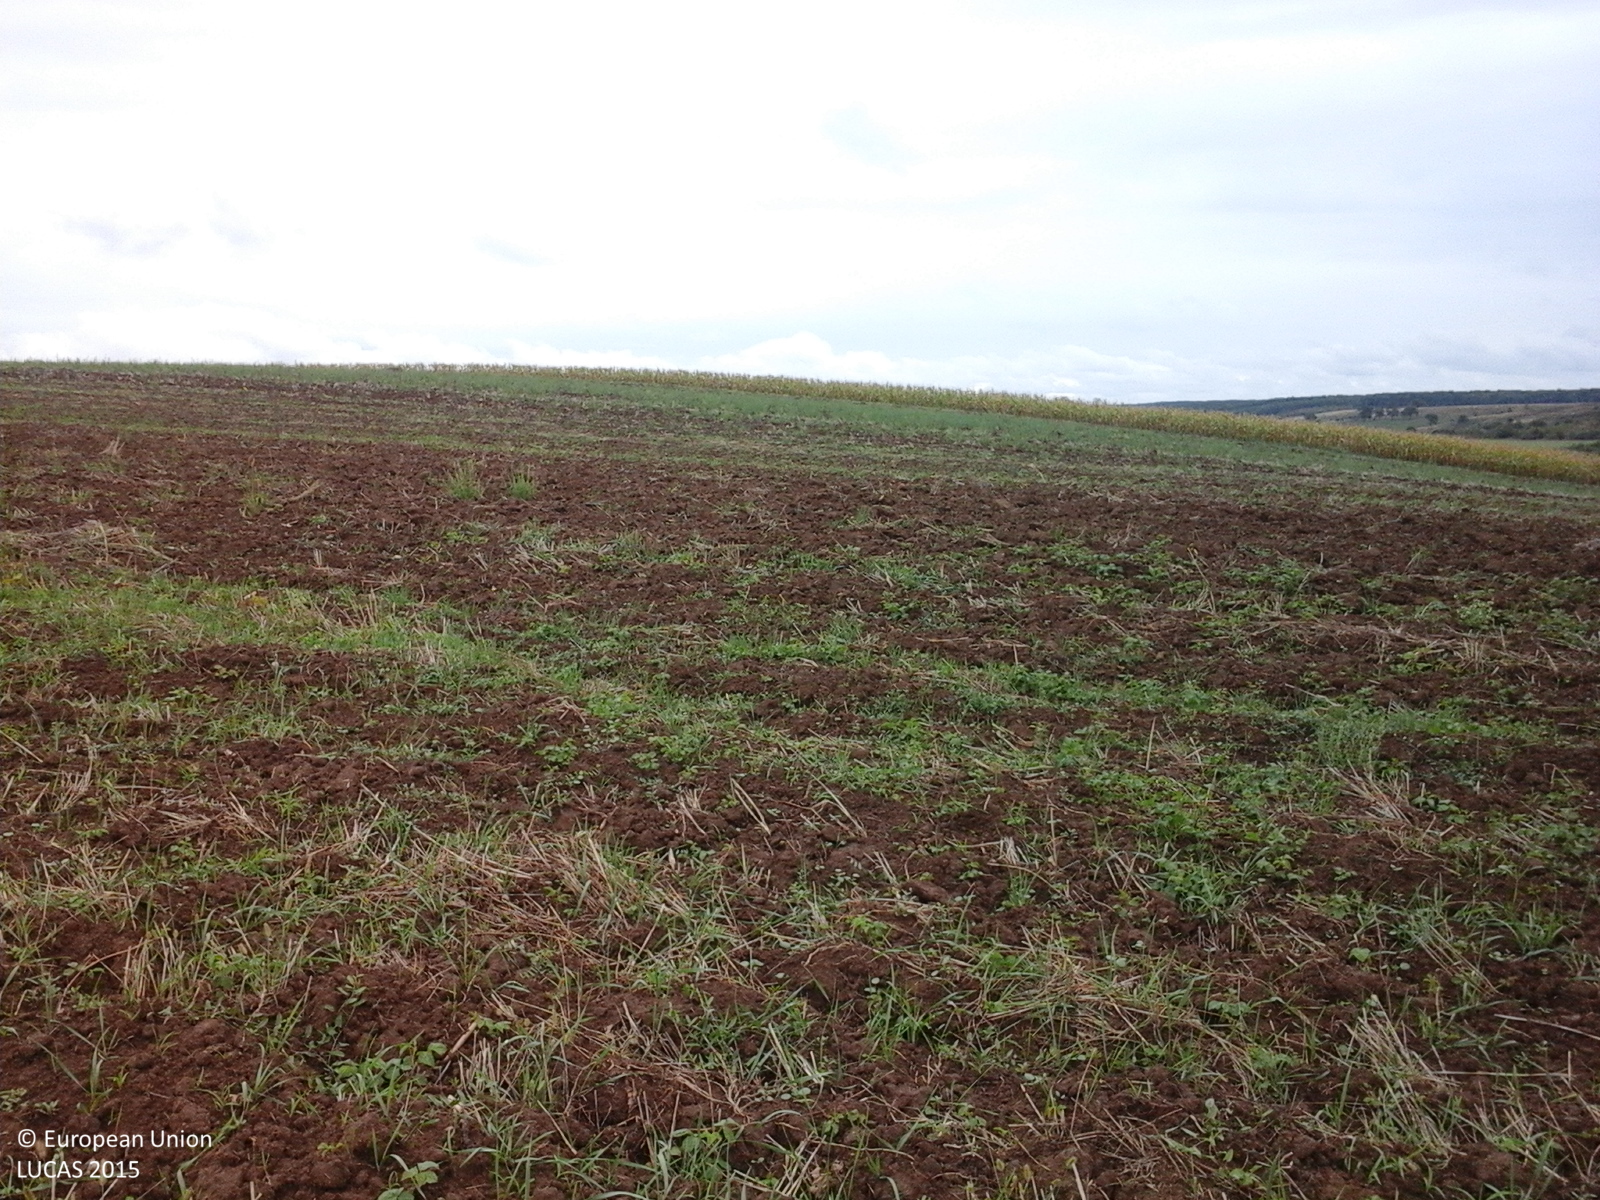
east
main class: Cropland
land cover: Common wheat
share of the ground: < 10 %
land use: Agriculture (excluding fallow land and kitchen gardens)
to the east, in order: Common wheat; Maize; Shruby margins; Tracks; Shruby margins; Tracks; Common wheat
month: September
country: RO
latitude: 46.8708
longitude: 21.8652
